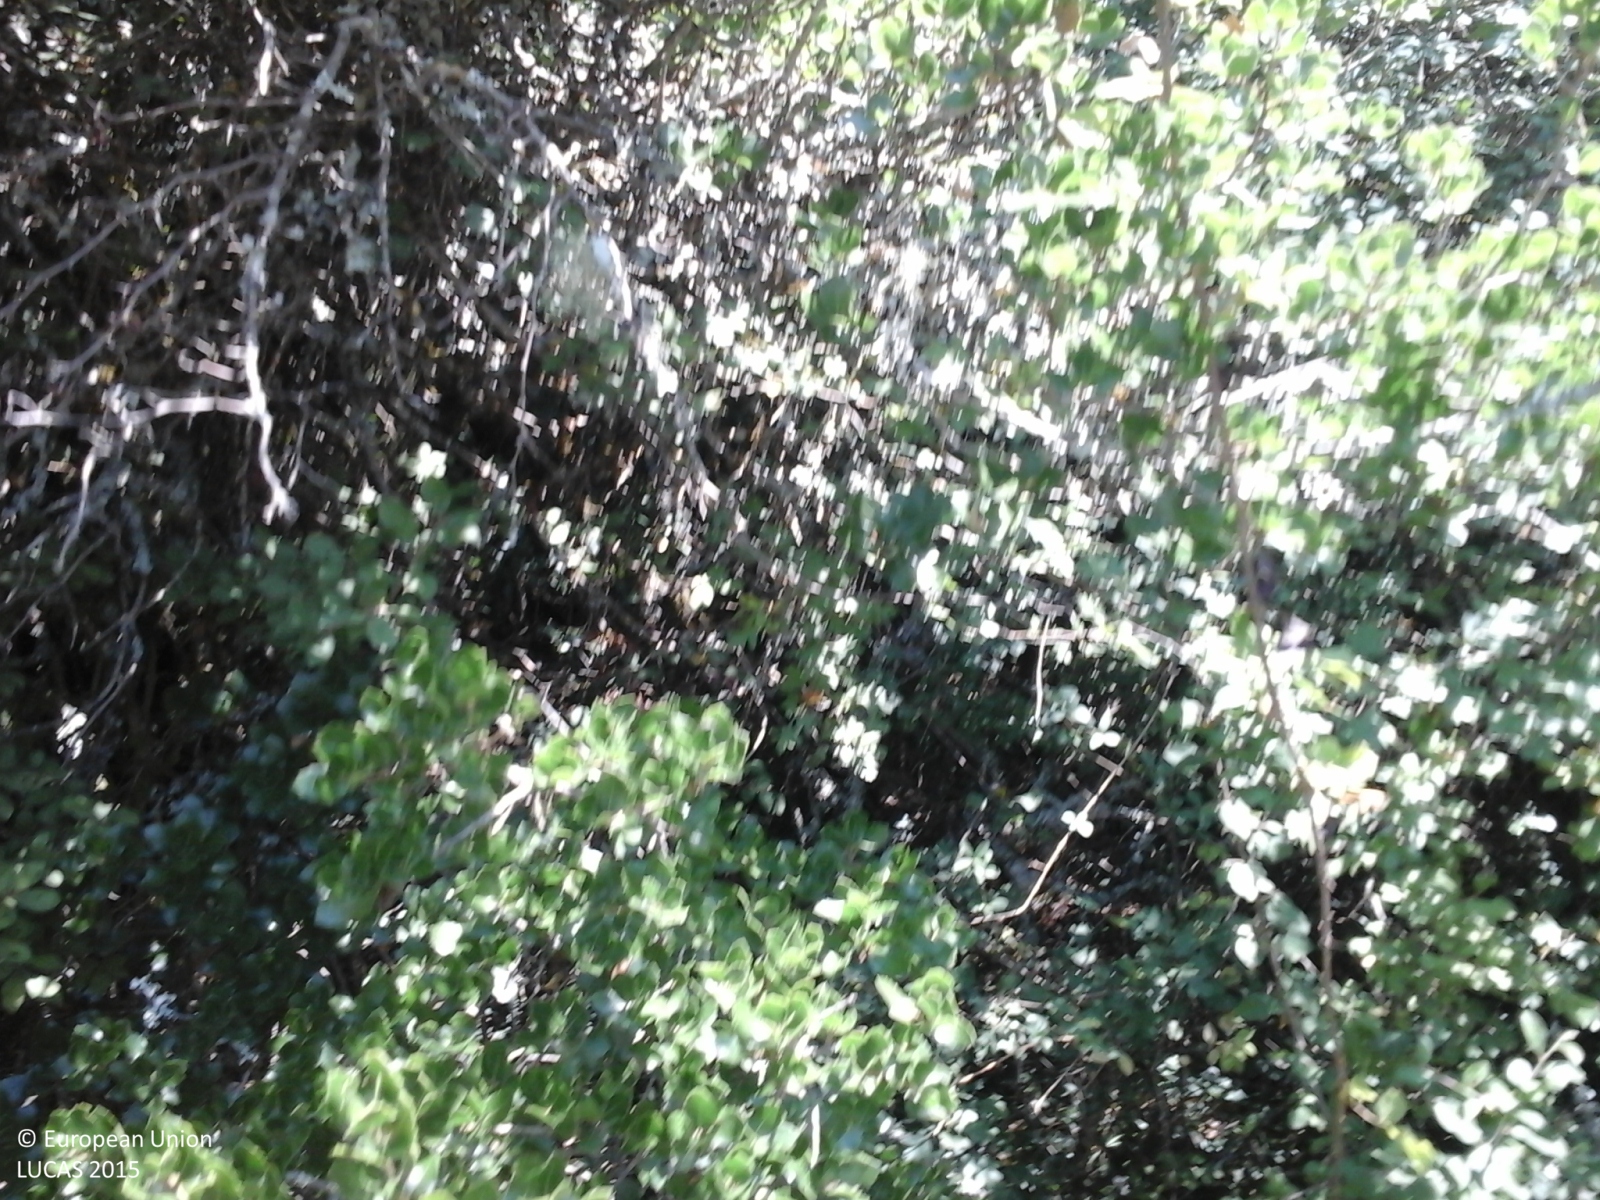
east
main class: Shrubland
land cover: Shrubland with sparse tree cover
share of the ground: > 75 %
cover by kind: shrubs 75 %, herbaceous plants 20 %, broadleaved forest trees 5 %
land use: Agriculture (excluding fallow land and kitchen gardens)
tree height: > 5 m
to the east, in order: Shrubland with sparse tree cover; Grassland without tree/shrub cover; Broadleaved woodland; Dry stone walls; Tracks; Broadleaved woodland
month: July
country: GR
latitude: 39.4381
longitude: 20.9095
